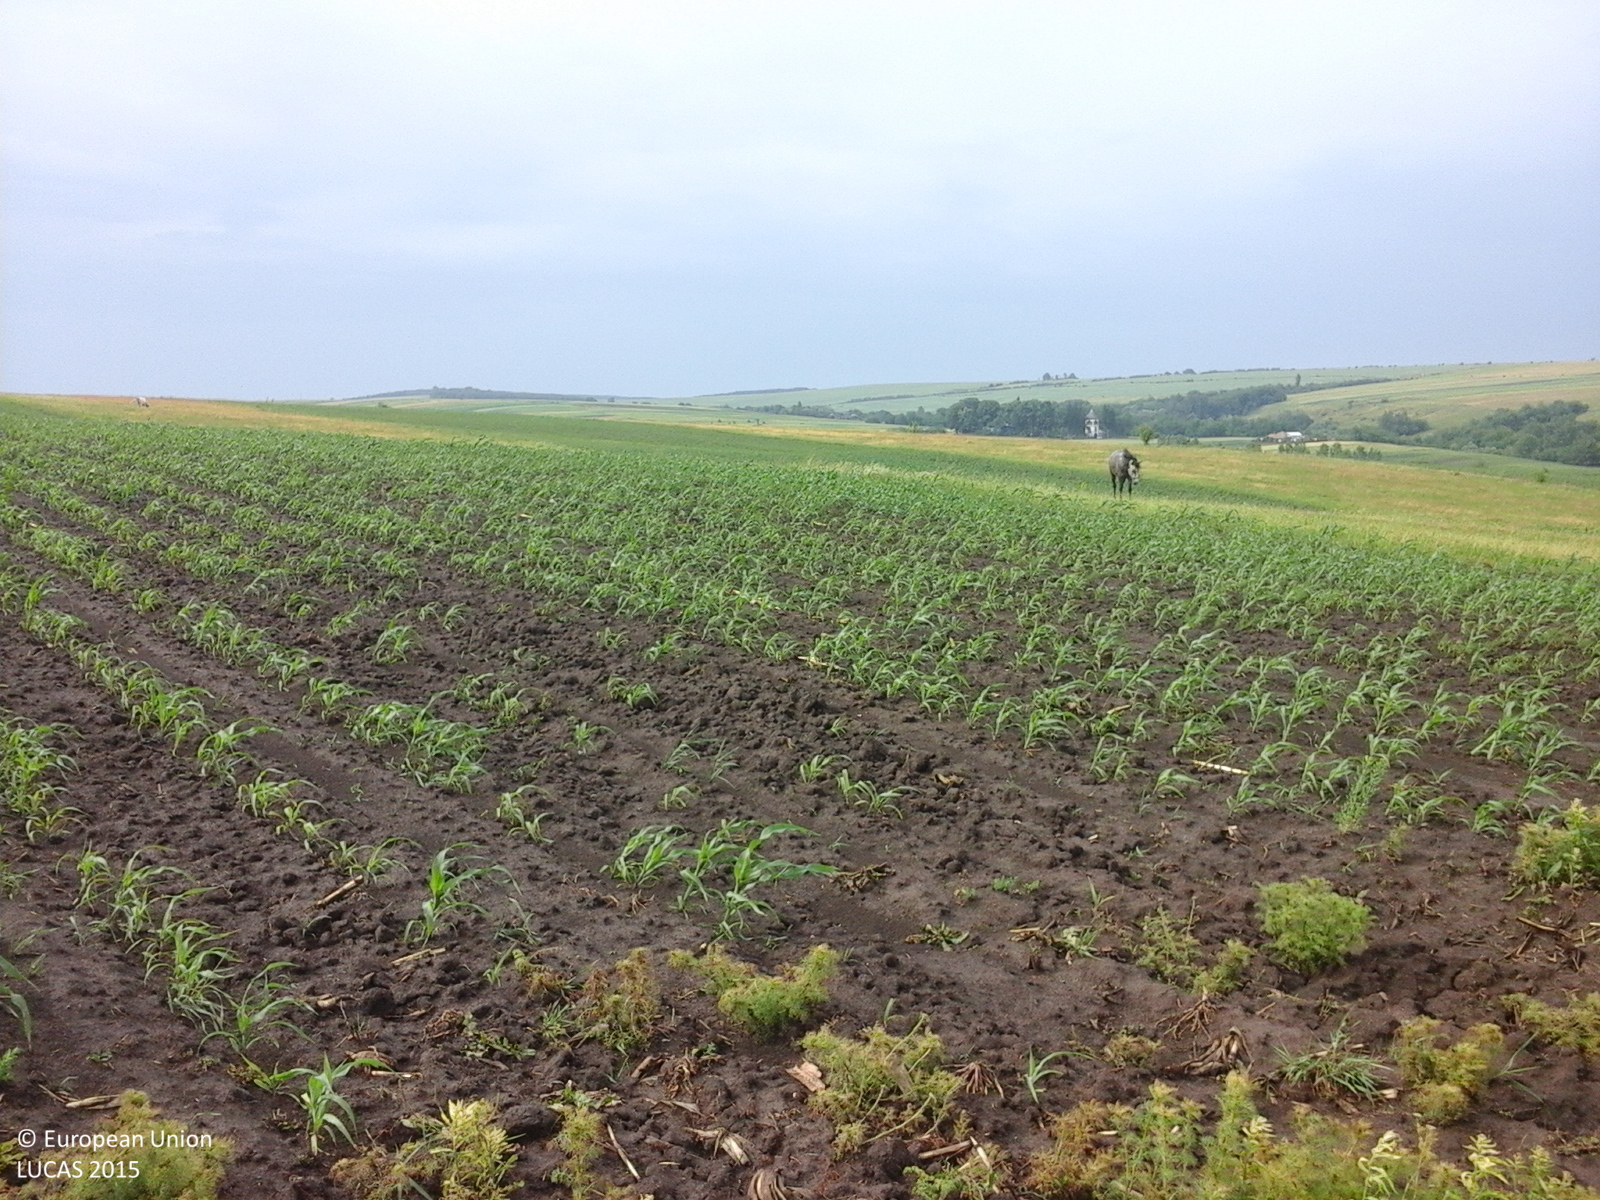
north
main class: Grassland
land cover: Grassland without tree/shrub cover
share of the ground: 25 - 50 %
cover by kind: herbaceous plants 100 %
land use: Agriculture (excluding fallow land and kitchen gardens)
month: June
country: RO
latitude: 47.3852
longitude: 26.4188
